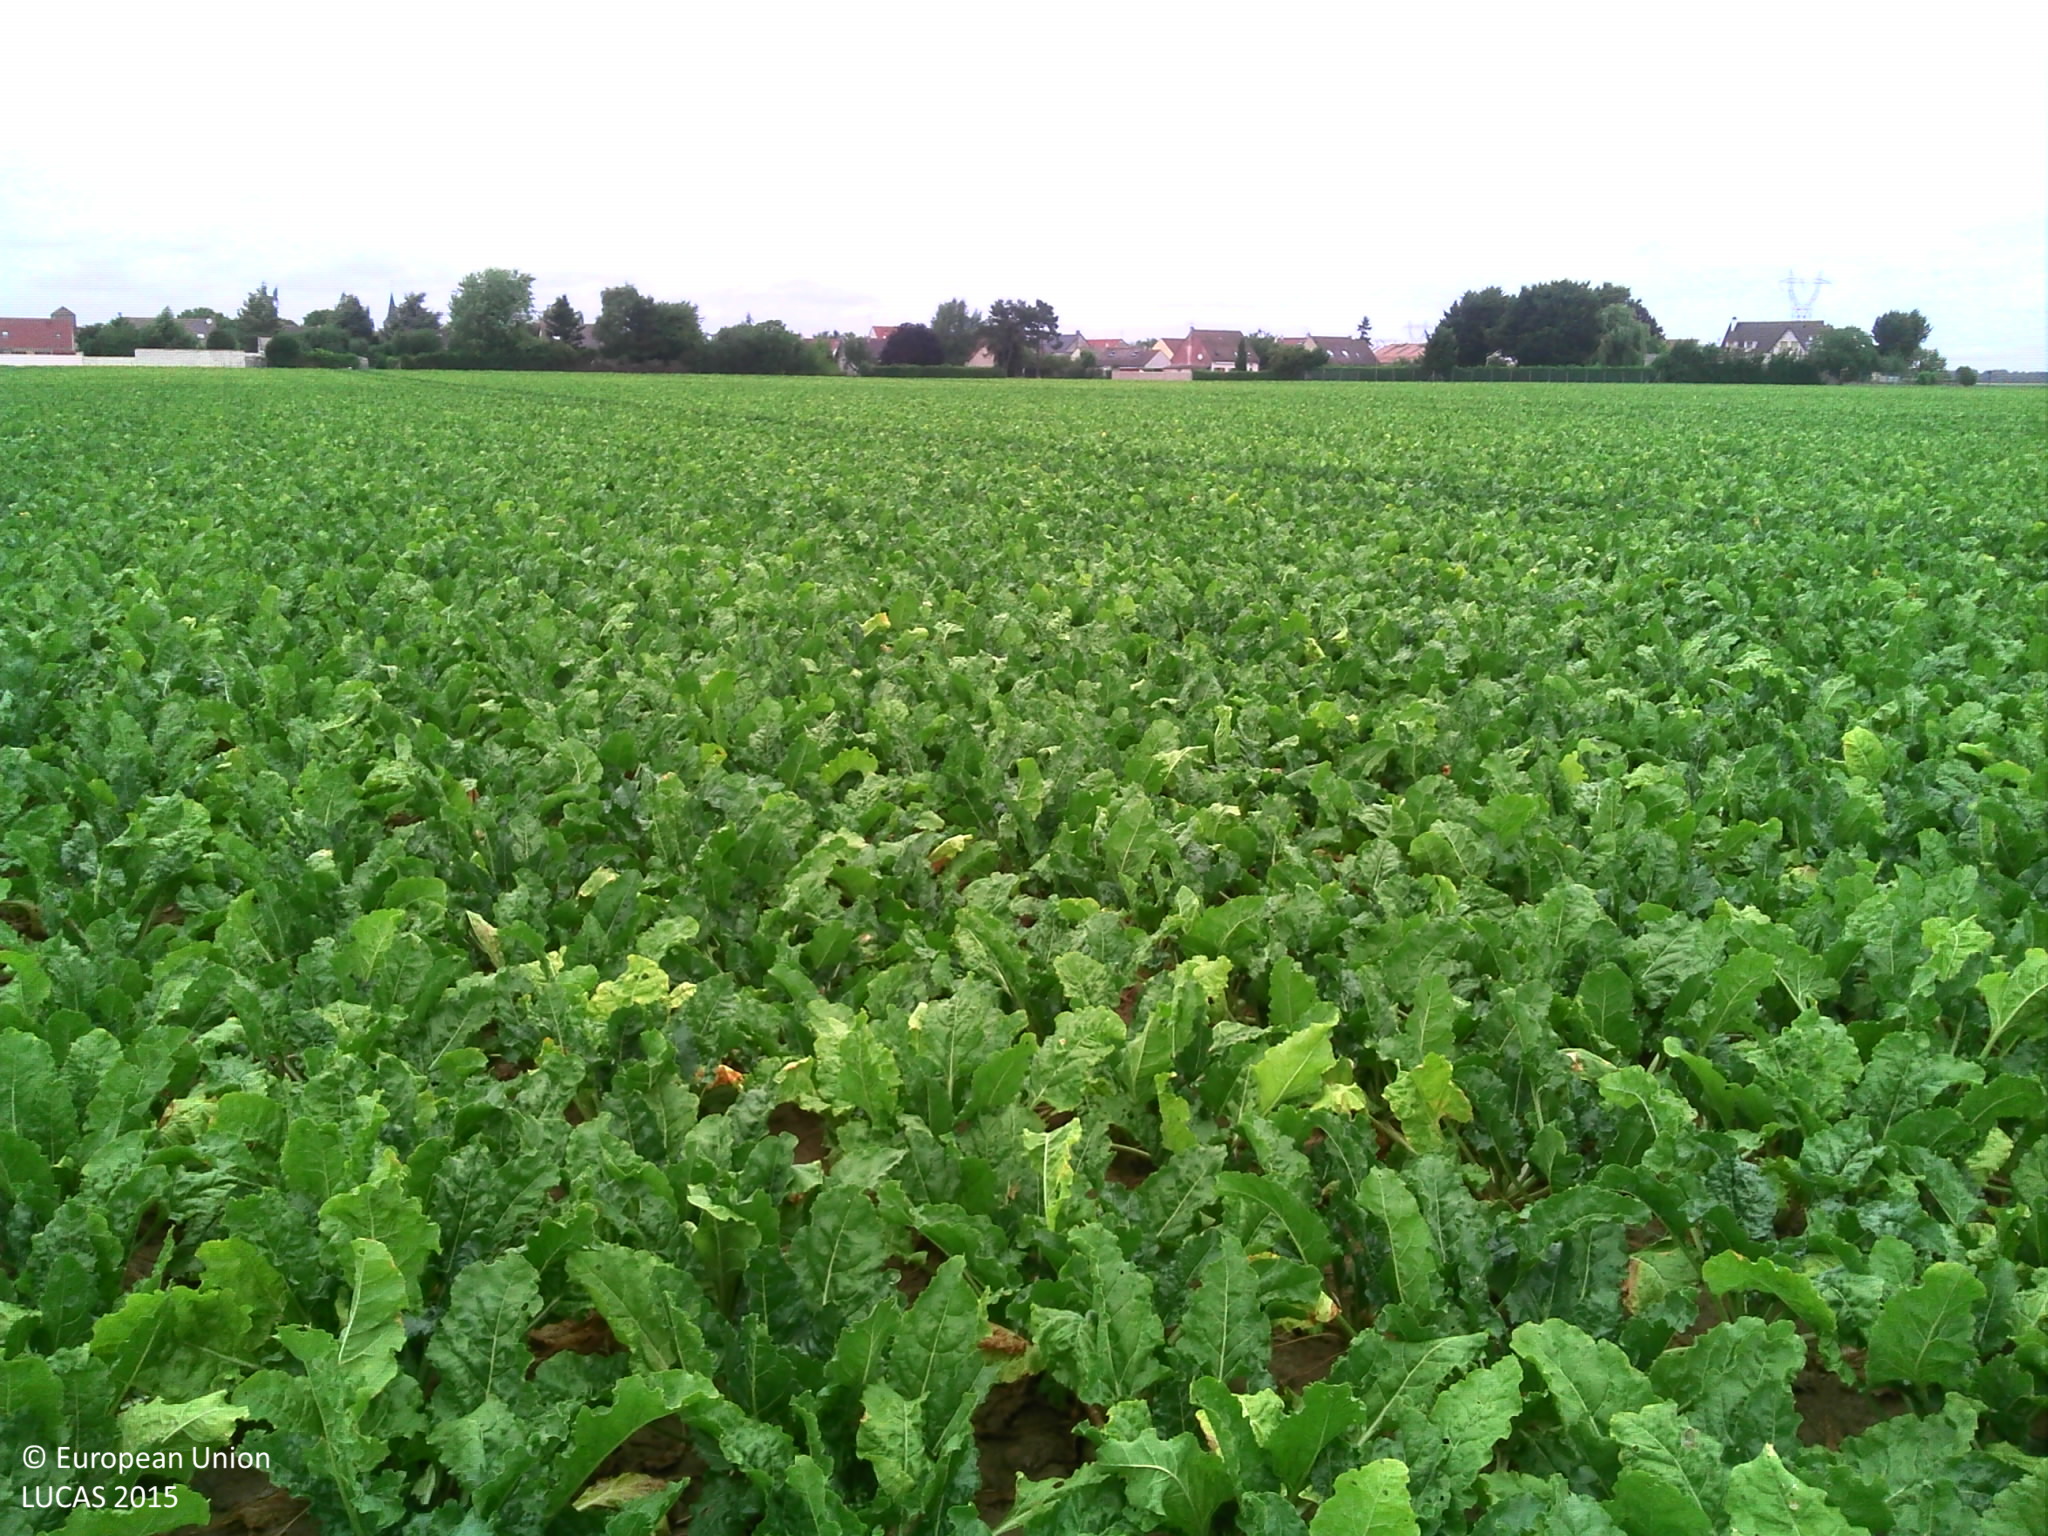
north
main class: Cropland
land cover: Sugar beet
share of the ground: > 75 %
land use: Agriculture (excluding fallow land and kitchen gardens)
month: July
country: FR
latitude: 48.6159
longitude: 2.7333
